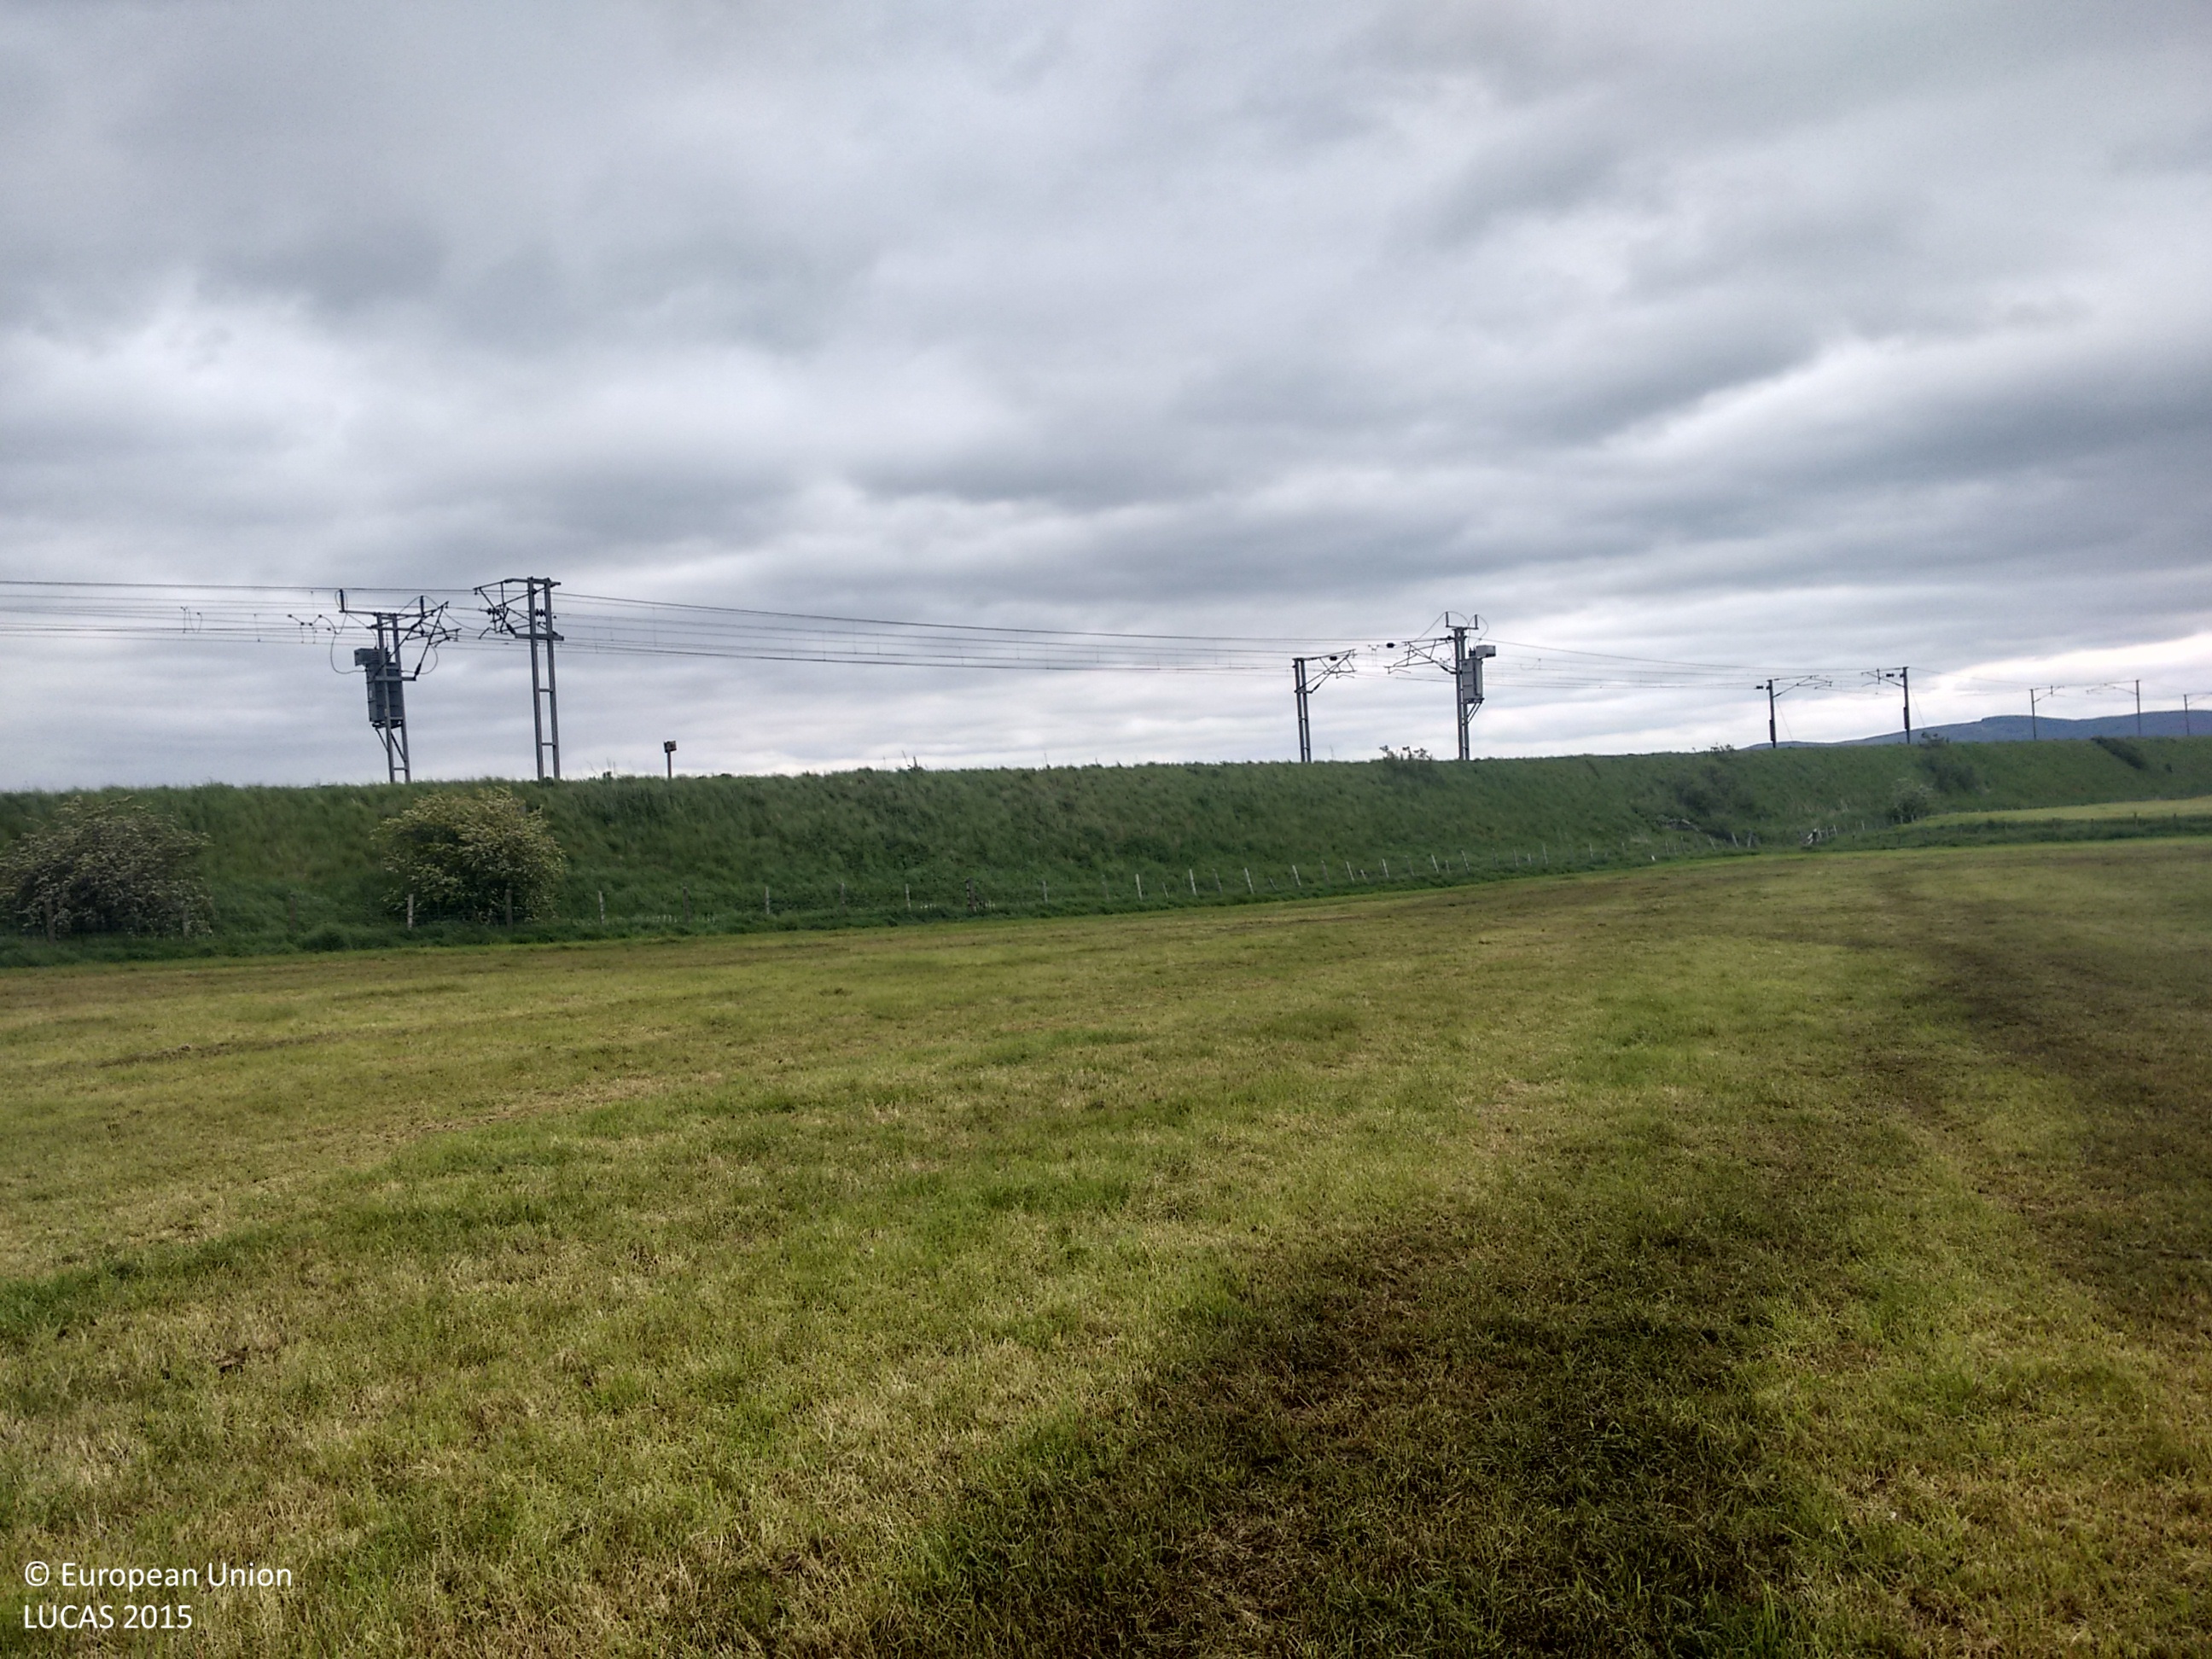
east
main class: Grassland
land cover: Grassland without tree/shrub cover
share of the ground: > 75 %
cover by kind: herbaceous plants 100 %
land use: Agriculture (excluding fallow land and kitchen gardens)
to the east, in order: Grassland without tree/shrub cover; Fences; Grass margins; Electric lines; Railways; Electric lines; Grass margins; Fences; Grassland without tree/shrub cover; Tracks; Grassland without tree/shrub cover; Fences; Grass margins; Rivers and streams; Grass margins; Fences; Grassland without tree/shrub cover; Other bare soil; Fences; Grass margins; Inland fresh running water
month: June
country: GB
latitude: 55.6734
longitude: -3.6446
